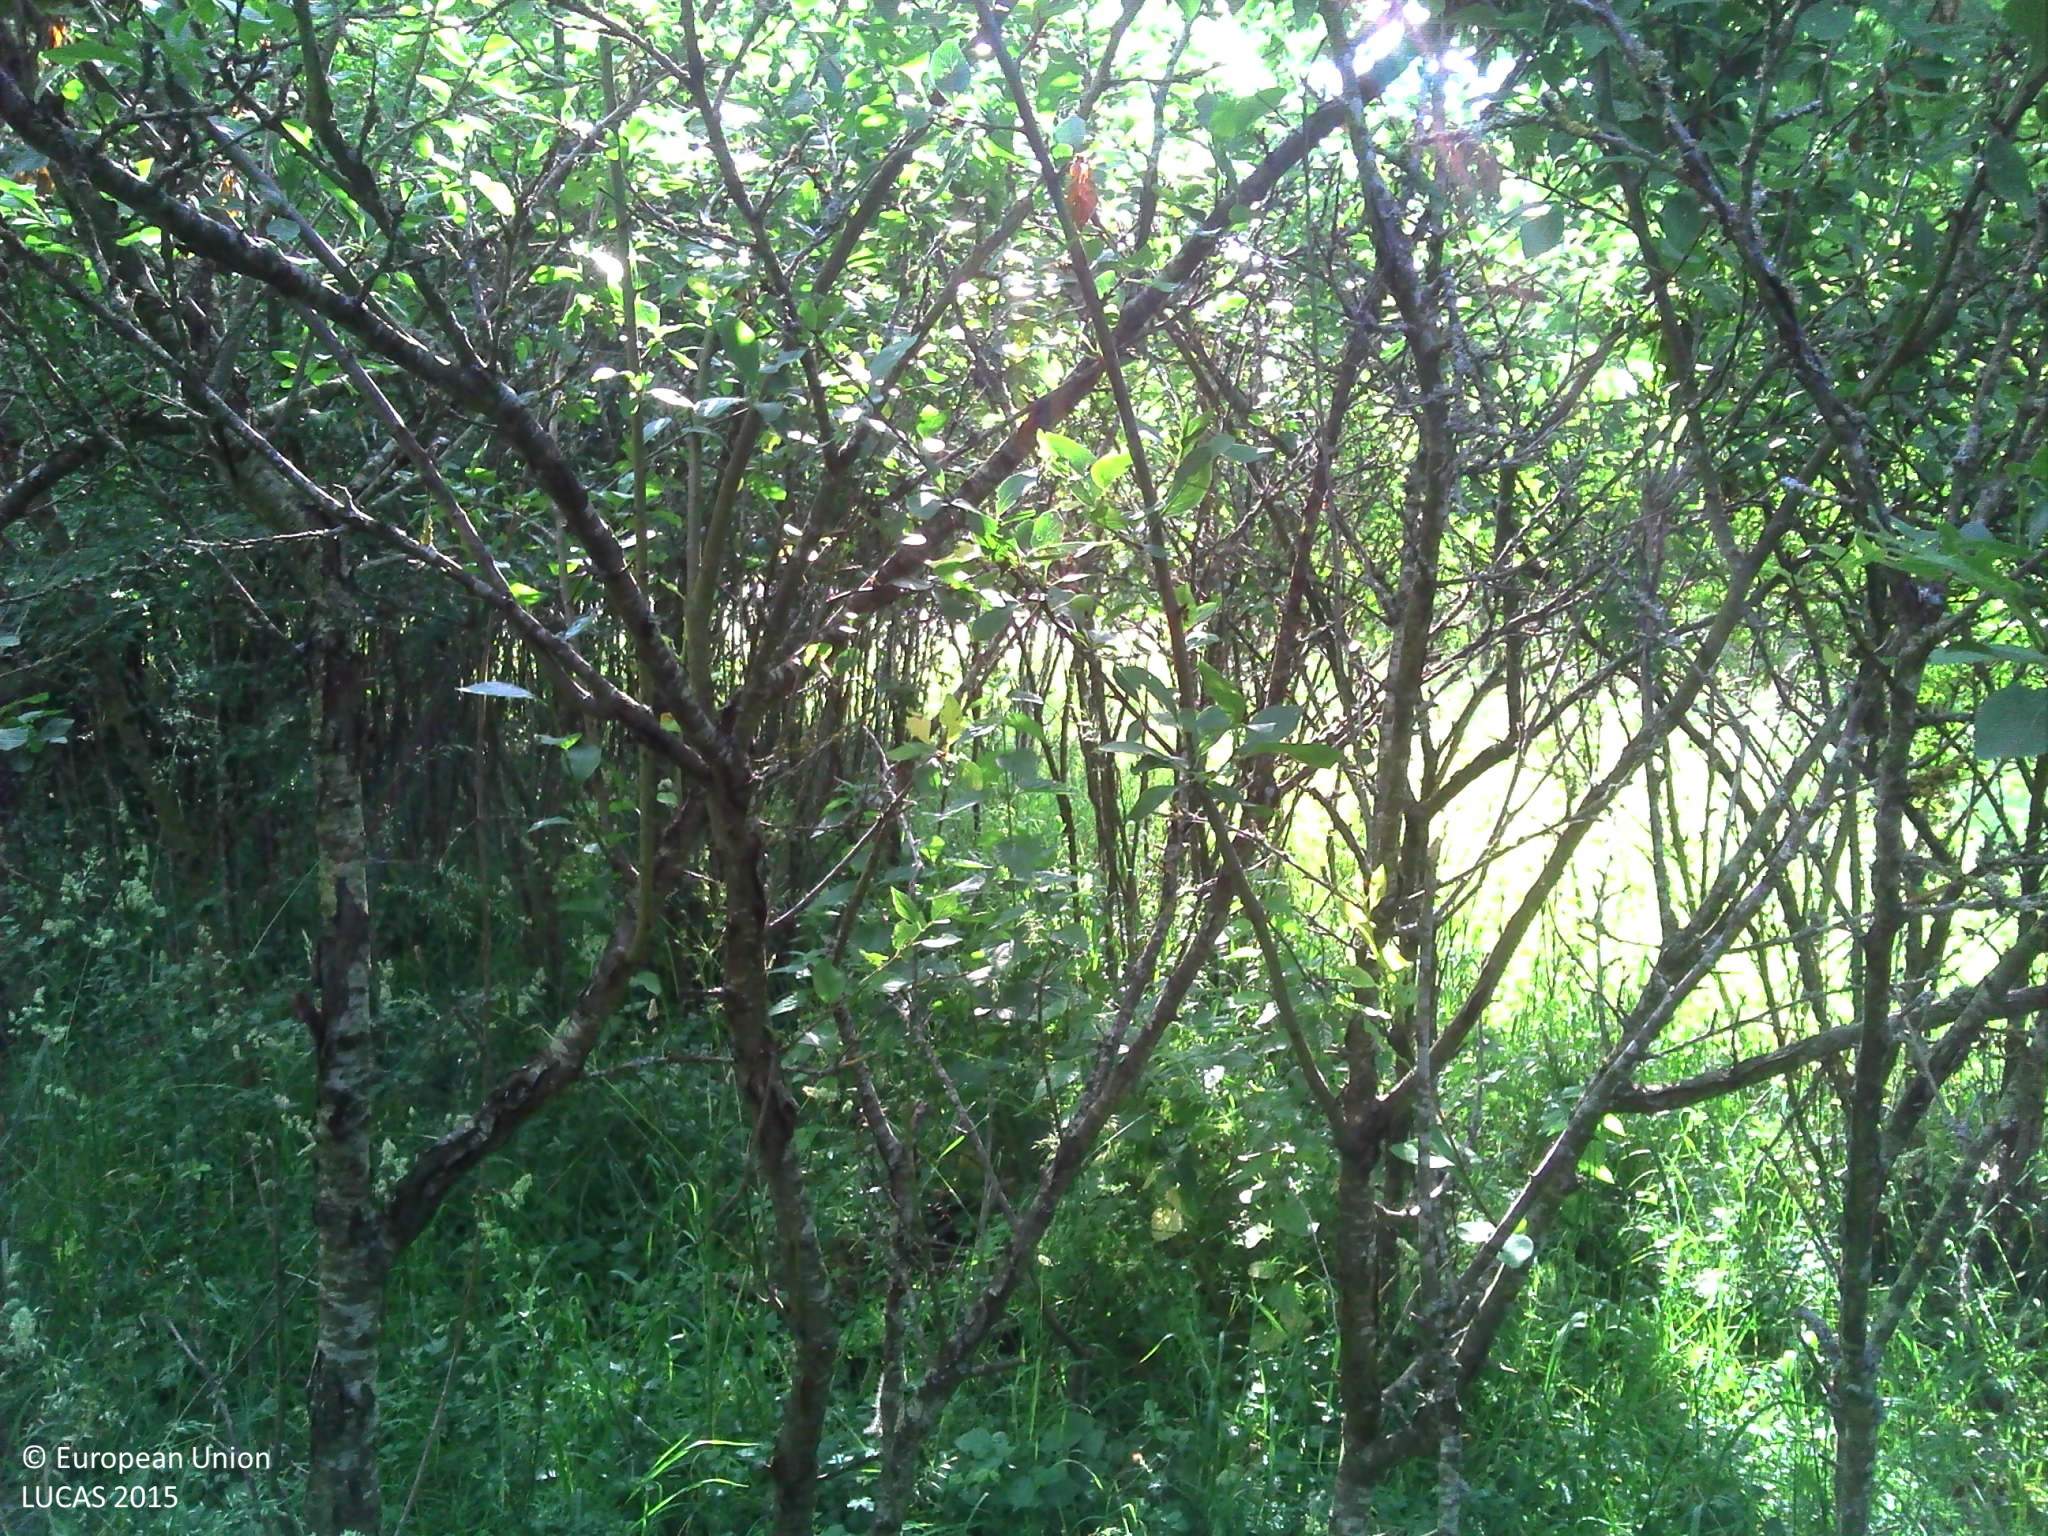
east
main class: Grassland
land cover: Grassland with sparse tree/shrub cover
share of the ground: > 75 %
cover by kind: herbaceous plants 95 %, broadleaved forest trees 5 %
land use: Residential
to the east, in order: Grassland with sparse tree/shrub cover; Artificial constructions in urban areas; Grassland without tree/shrub cover; Artificial constructions in urban areas; Other fruit trees and berries; Electric lines; Other fruit trees and berries; Grassland without tree/shrub cover; Other fruit trees and berries
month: June
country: FR
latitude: 48.7554
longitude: 6.2867
